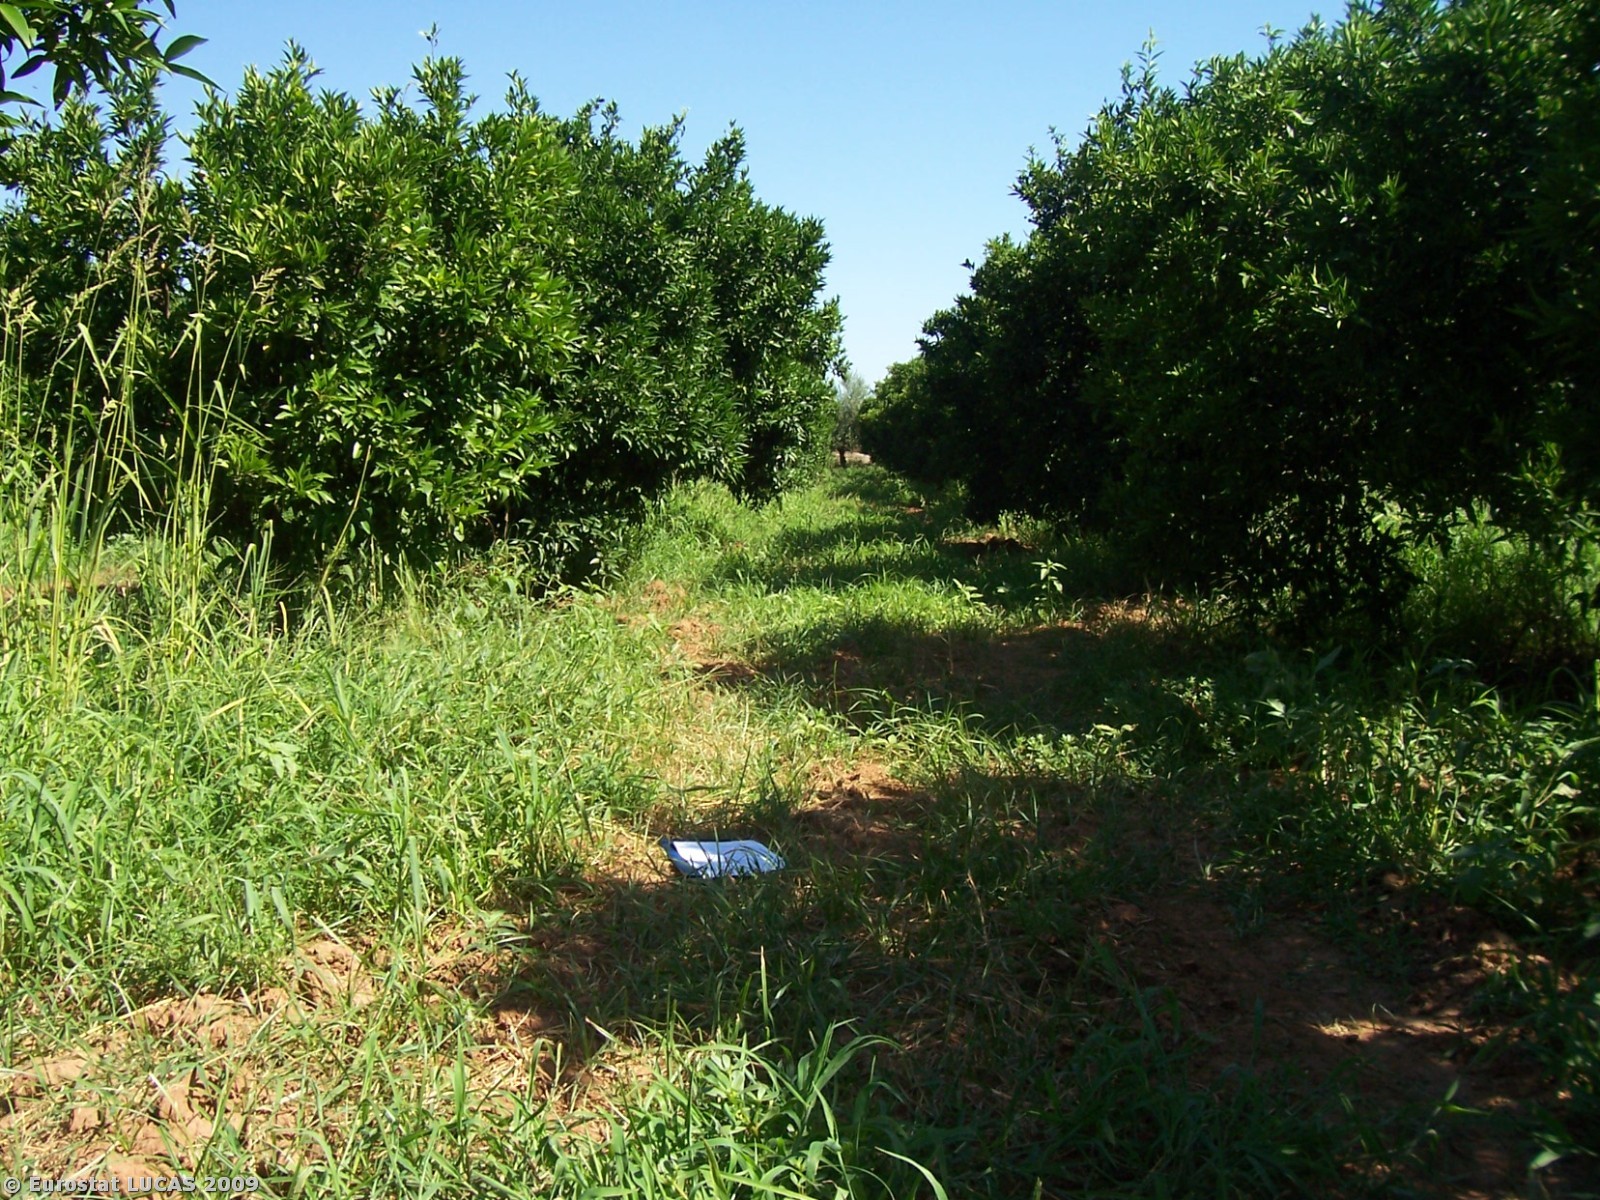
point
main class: Cropland
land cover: Other citrus fruit
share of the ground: 50 - 75 %
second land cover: Spontaneously vegetated surfaces
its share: > 75 %
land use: Agriculture (excluding fallow land and kitchen gardens)
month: July
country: IT
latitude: 40.5795
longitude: 17.0054
